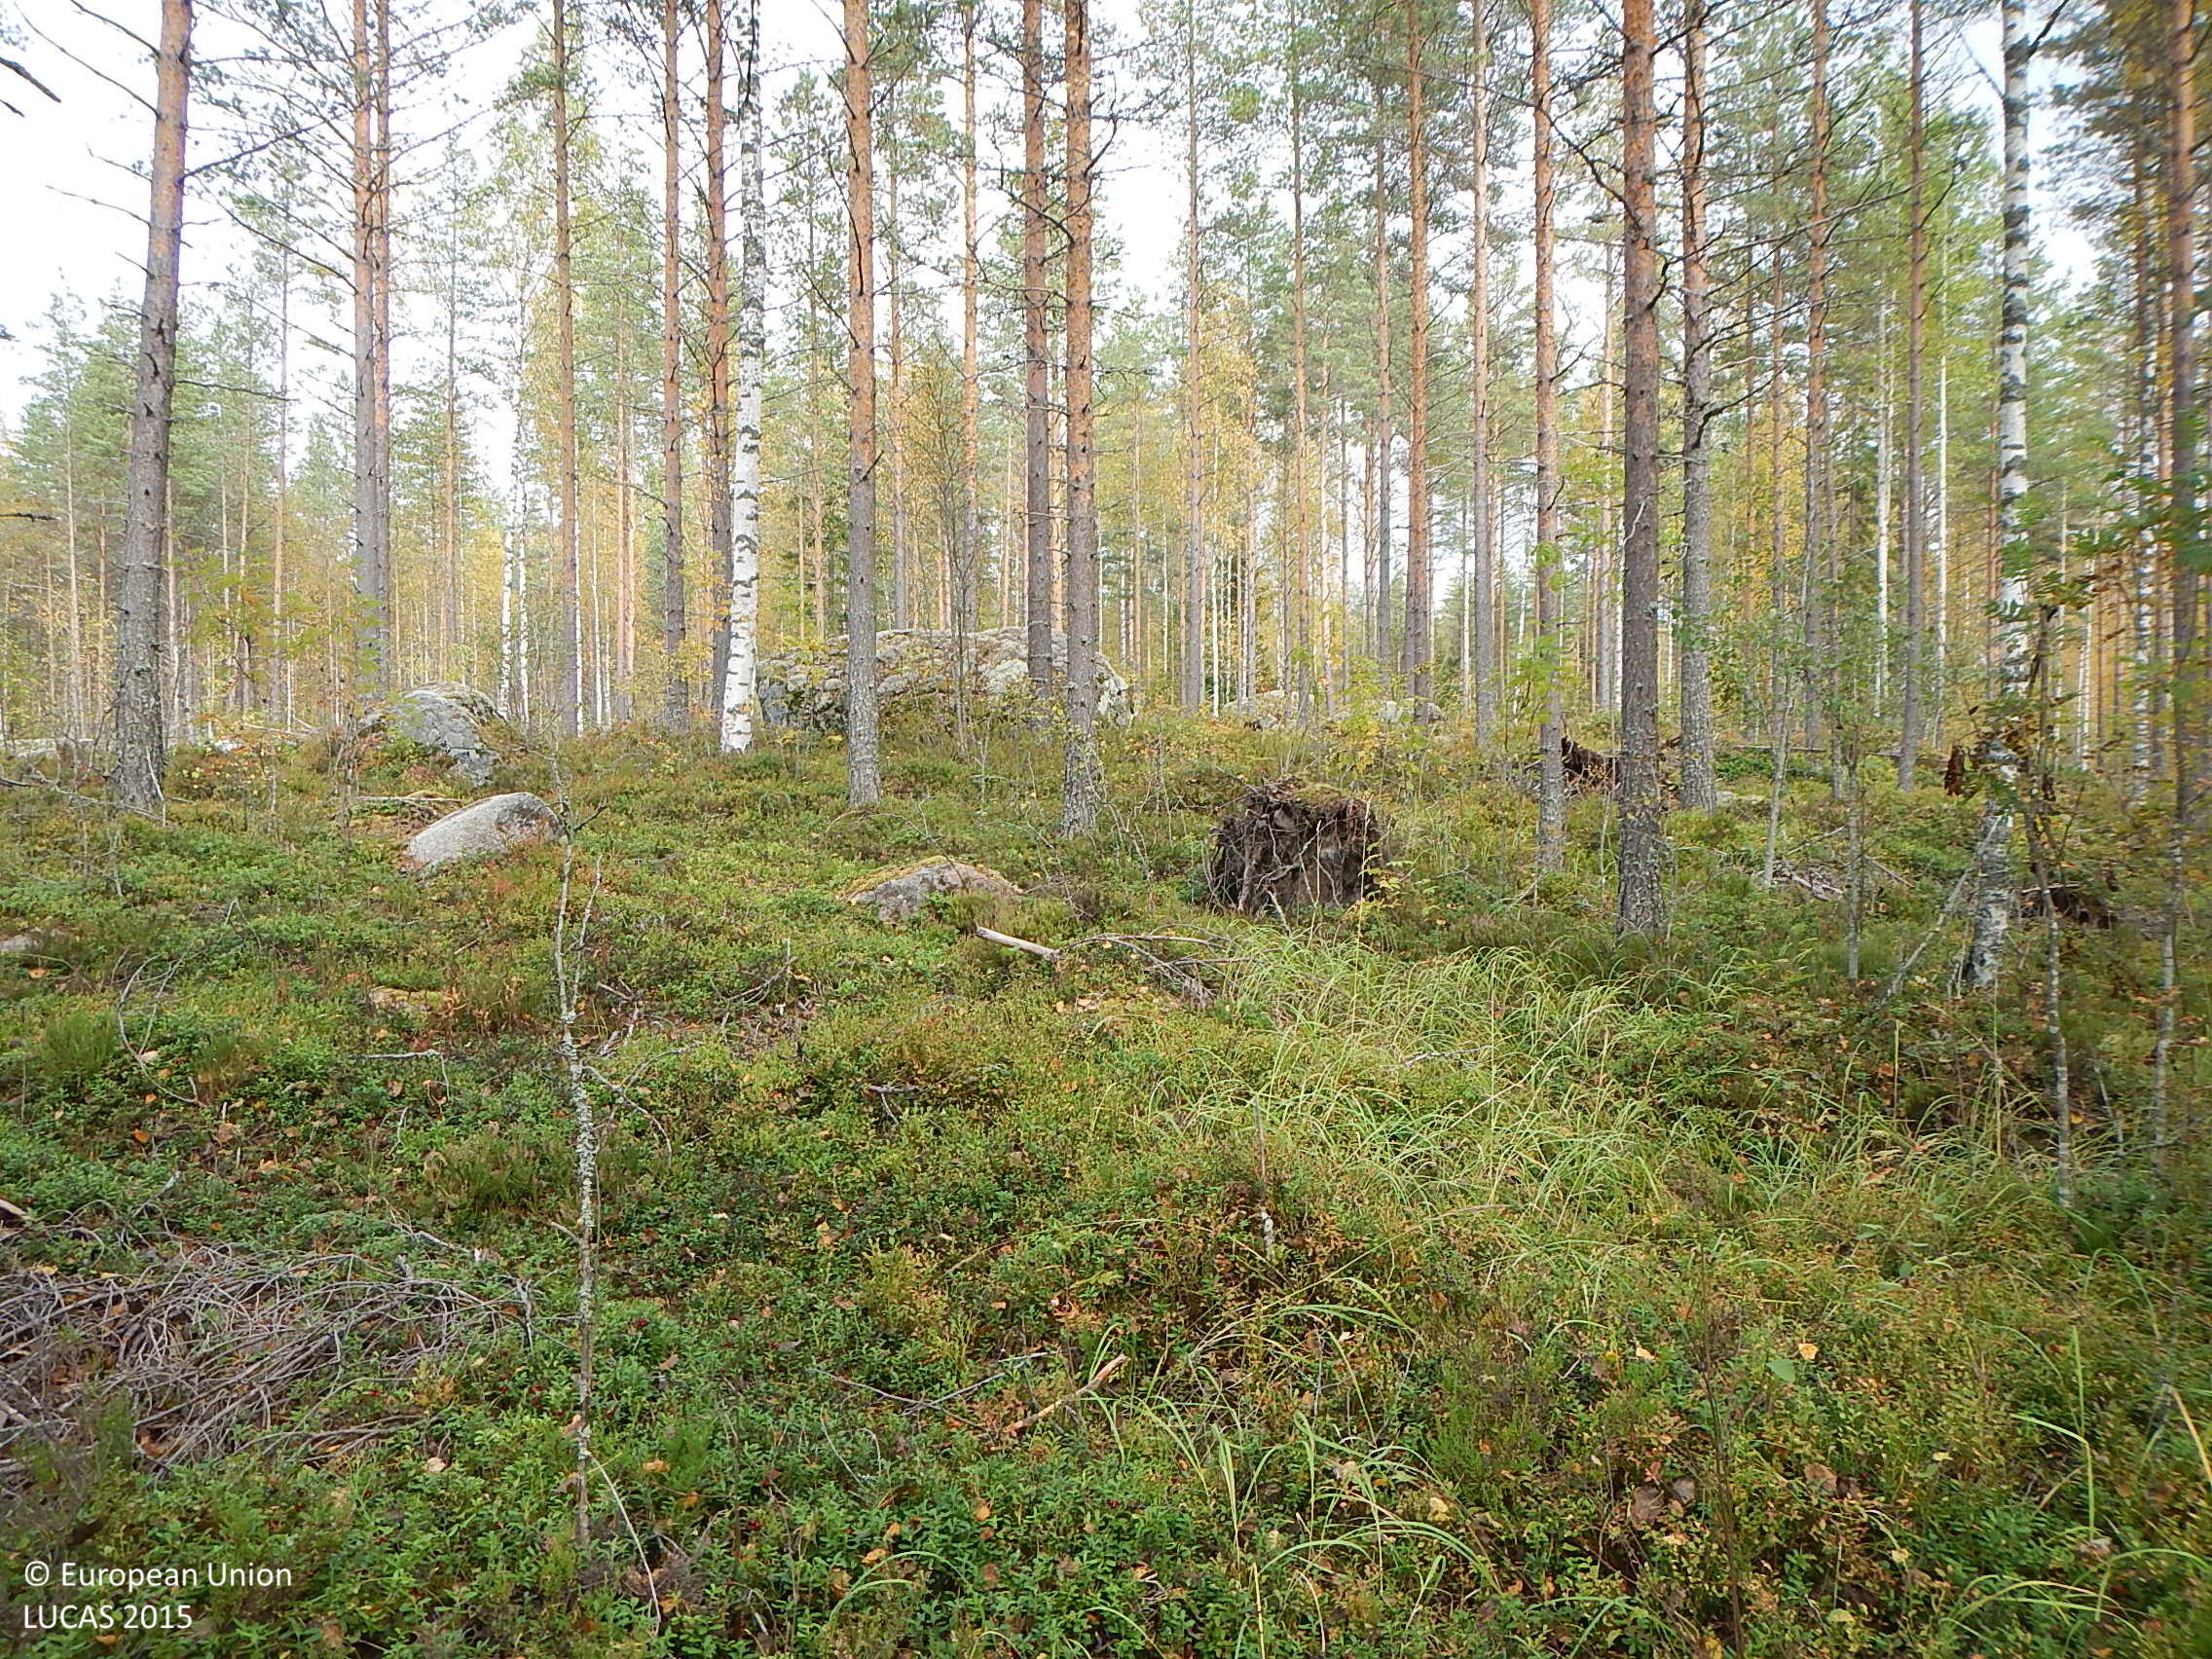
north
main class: Woodland
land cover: Pine dominated mixed woodland
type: boreal forest
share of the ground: > 75 %
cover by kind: coniferous forest trees 40 %, broadleaved forest trees 35 %, shrubs 25 %
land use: Forestry
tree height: > 5 m
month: September
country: FI
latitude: 61.9231
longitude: 22.7290
